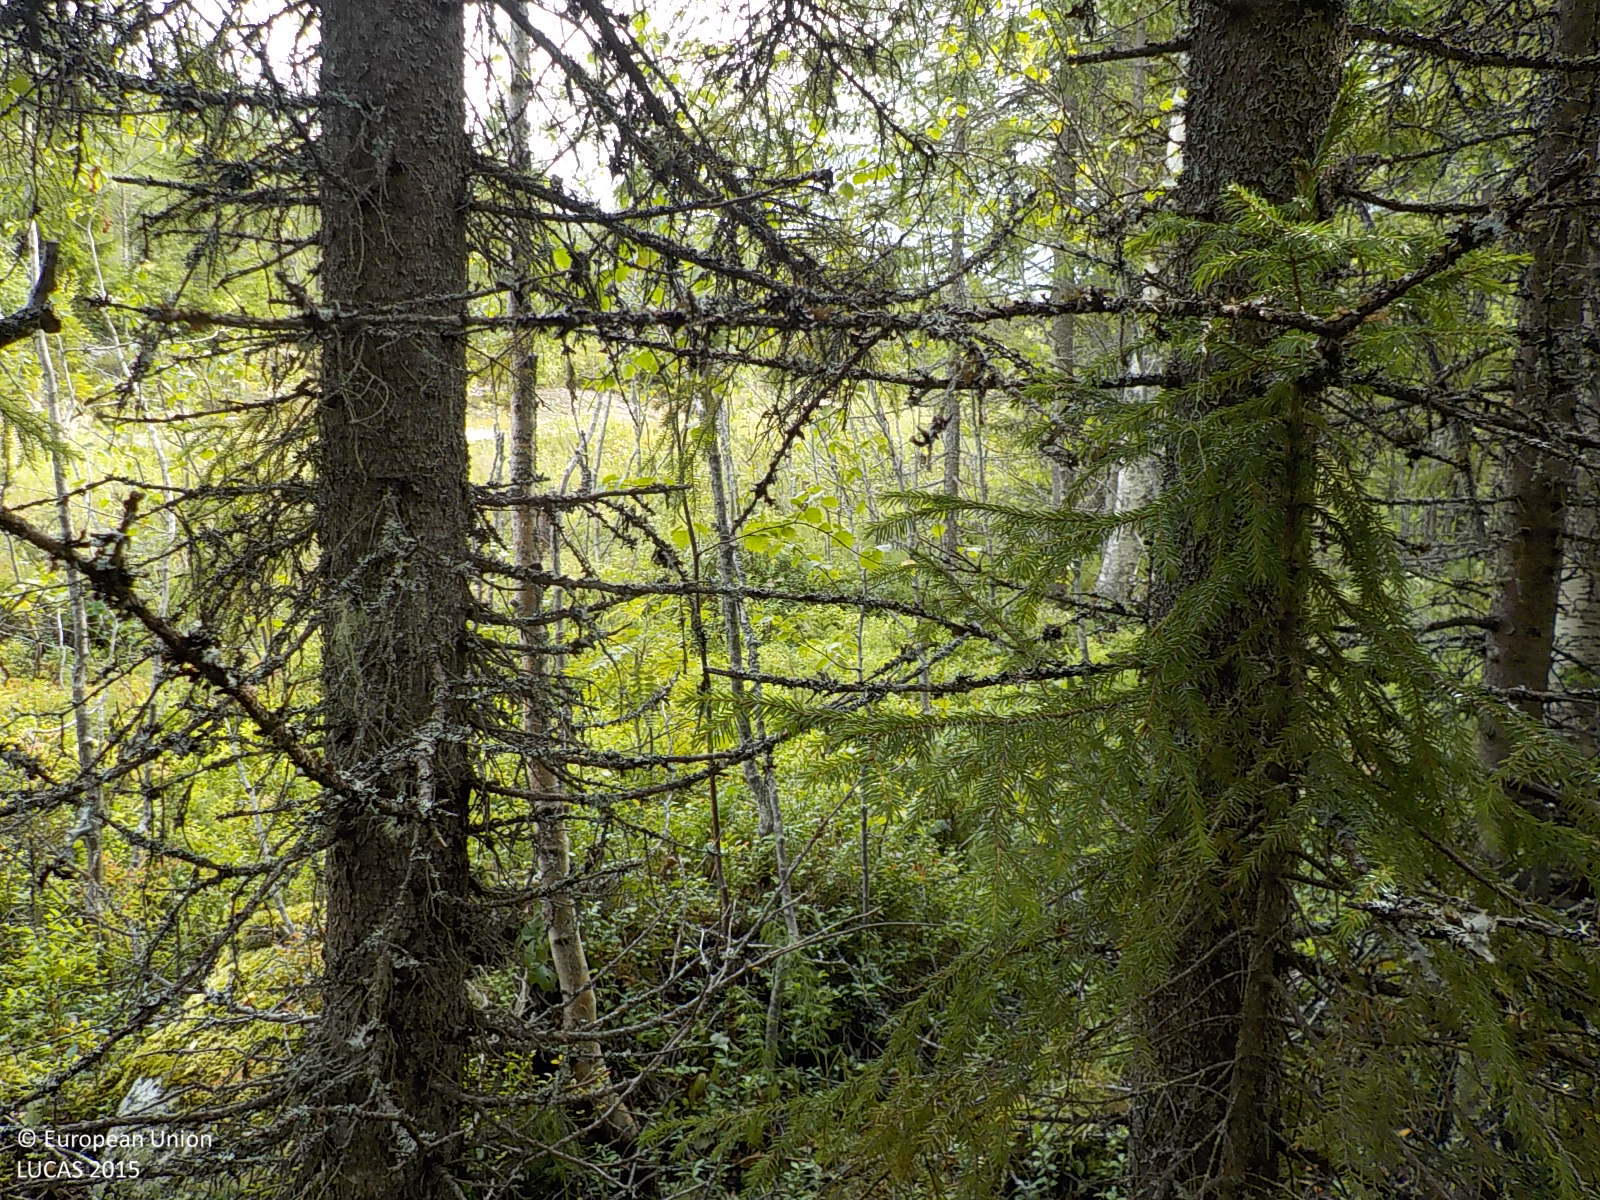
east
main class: Woodland
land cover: Spruce dominated coniferous woodland
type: boreal forest
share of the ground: > 75 %
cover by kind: coniferous forest trees 95 %, shrubs 5 %
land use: Forestry
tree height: > 5 m
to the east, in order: Spruce dominated coniferous woodland; Broadleaved woodland; Paved roads, cycling and walking lanes; Ditches and canals; Pine dominated coniferous woodland; Pine dominated mixed woodland; Spruce dominated coniferous woodland
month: September
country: SE
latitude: 63.3000
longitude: 17.7755
